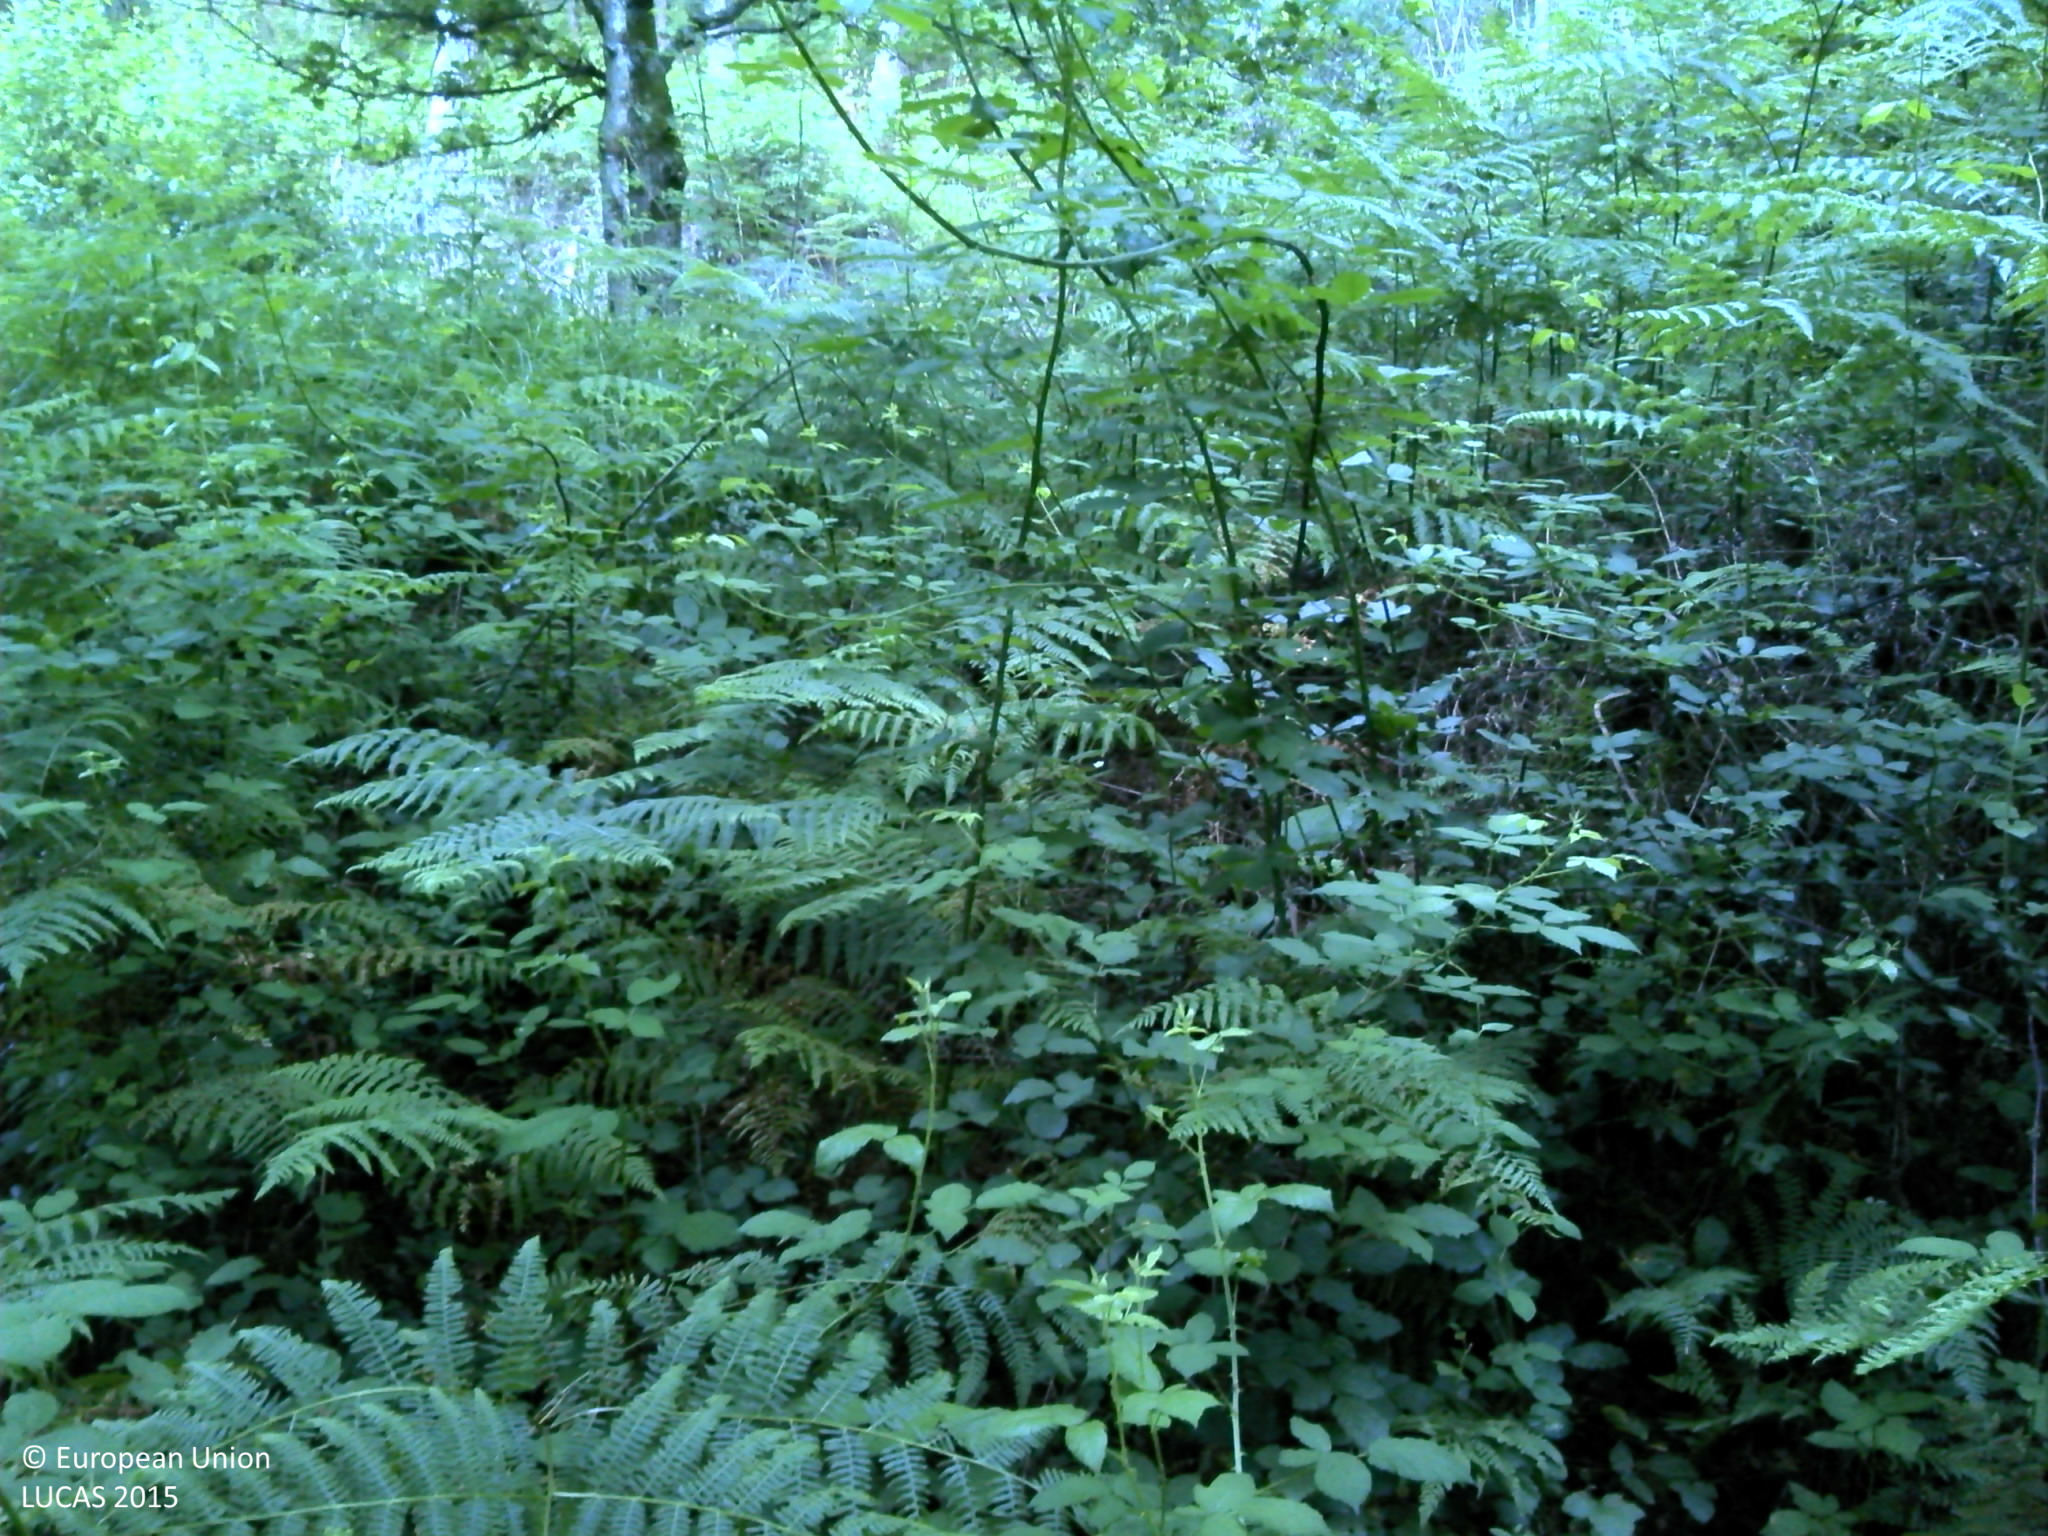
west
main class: Woodland
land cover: Broadleaved woodland
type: acidophilous oak and oak-birch forest
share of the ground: 50 - 75 %
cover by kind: broadleaved forest trees 75 %, shrubs 20 %, herbaceous plants 5 %
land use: Forestry
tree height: > 5 m
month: May
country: PT
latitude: 41.9375
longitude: -8.6567
